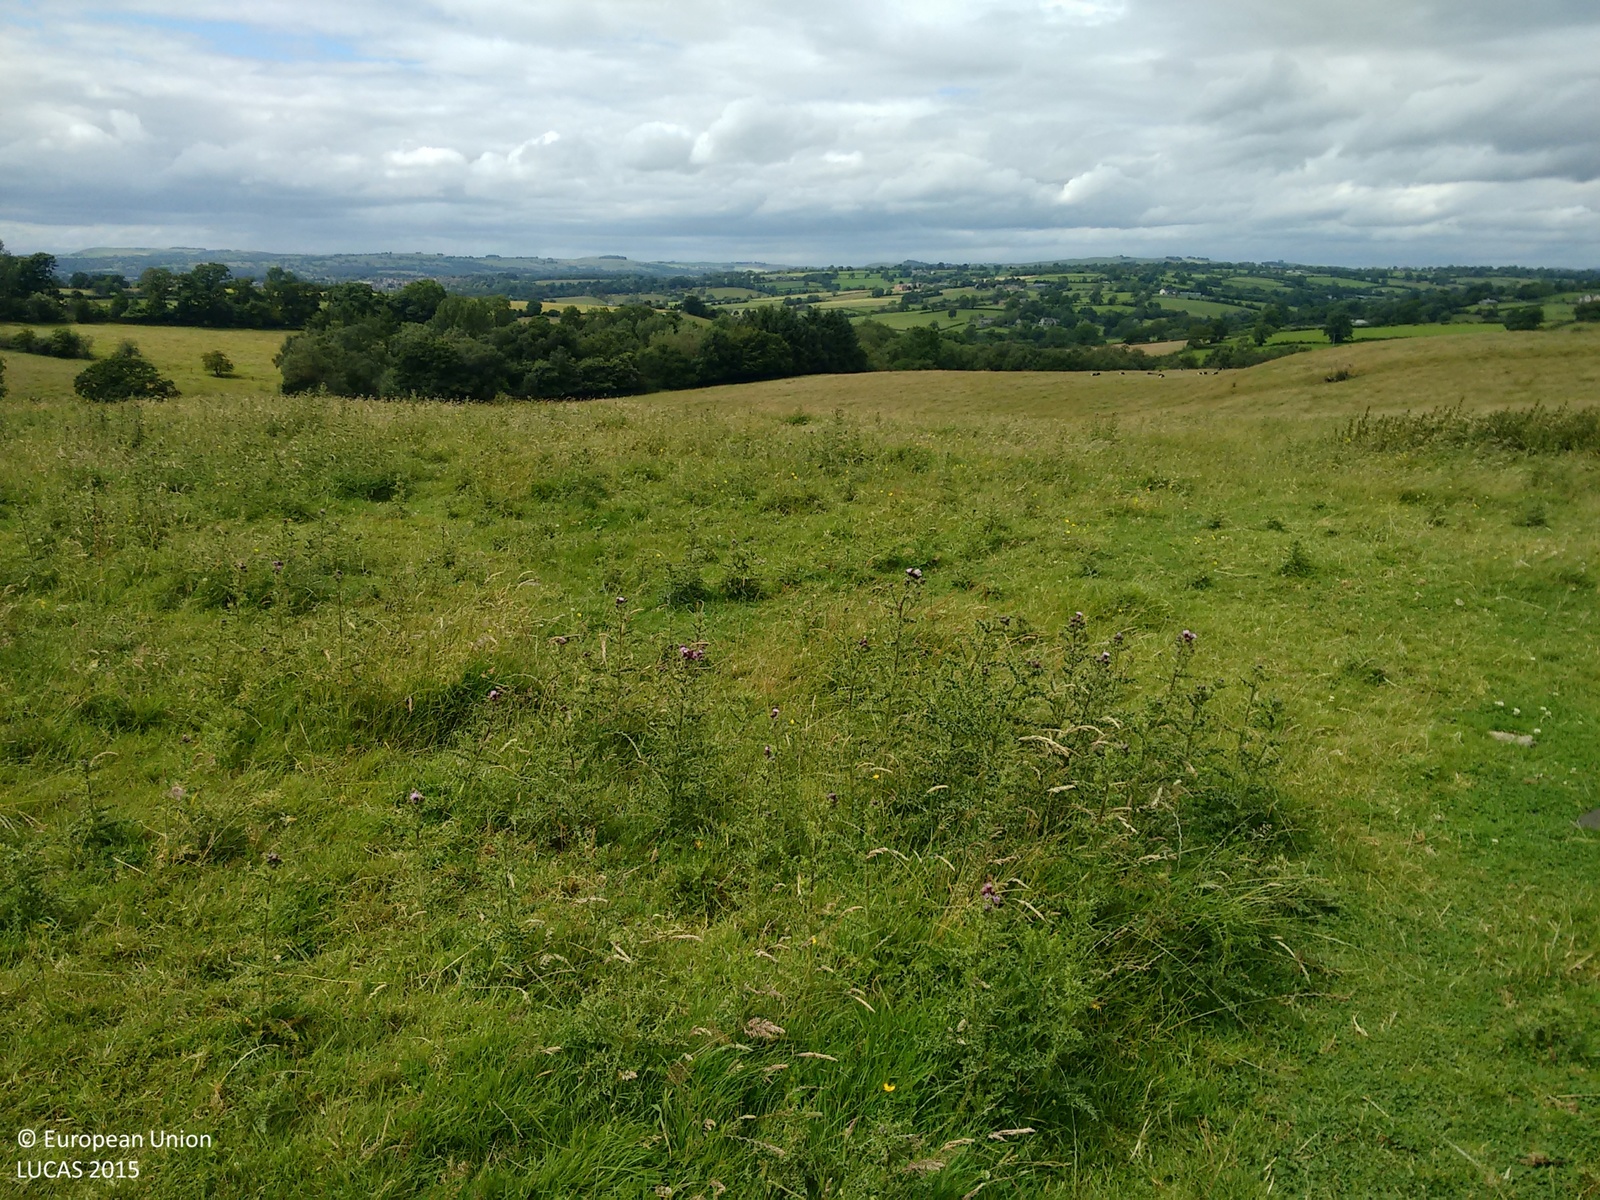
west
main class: Grassland
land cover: Grassland without tree/shrub cover
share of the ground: > 75 %
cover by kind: herbaceous plants 100 %
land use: Agriculture (excluding fallow land and kitchen gardens)
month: July
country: GB
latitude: 53.0176
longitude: -1.6652
